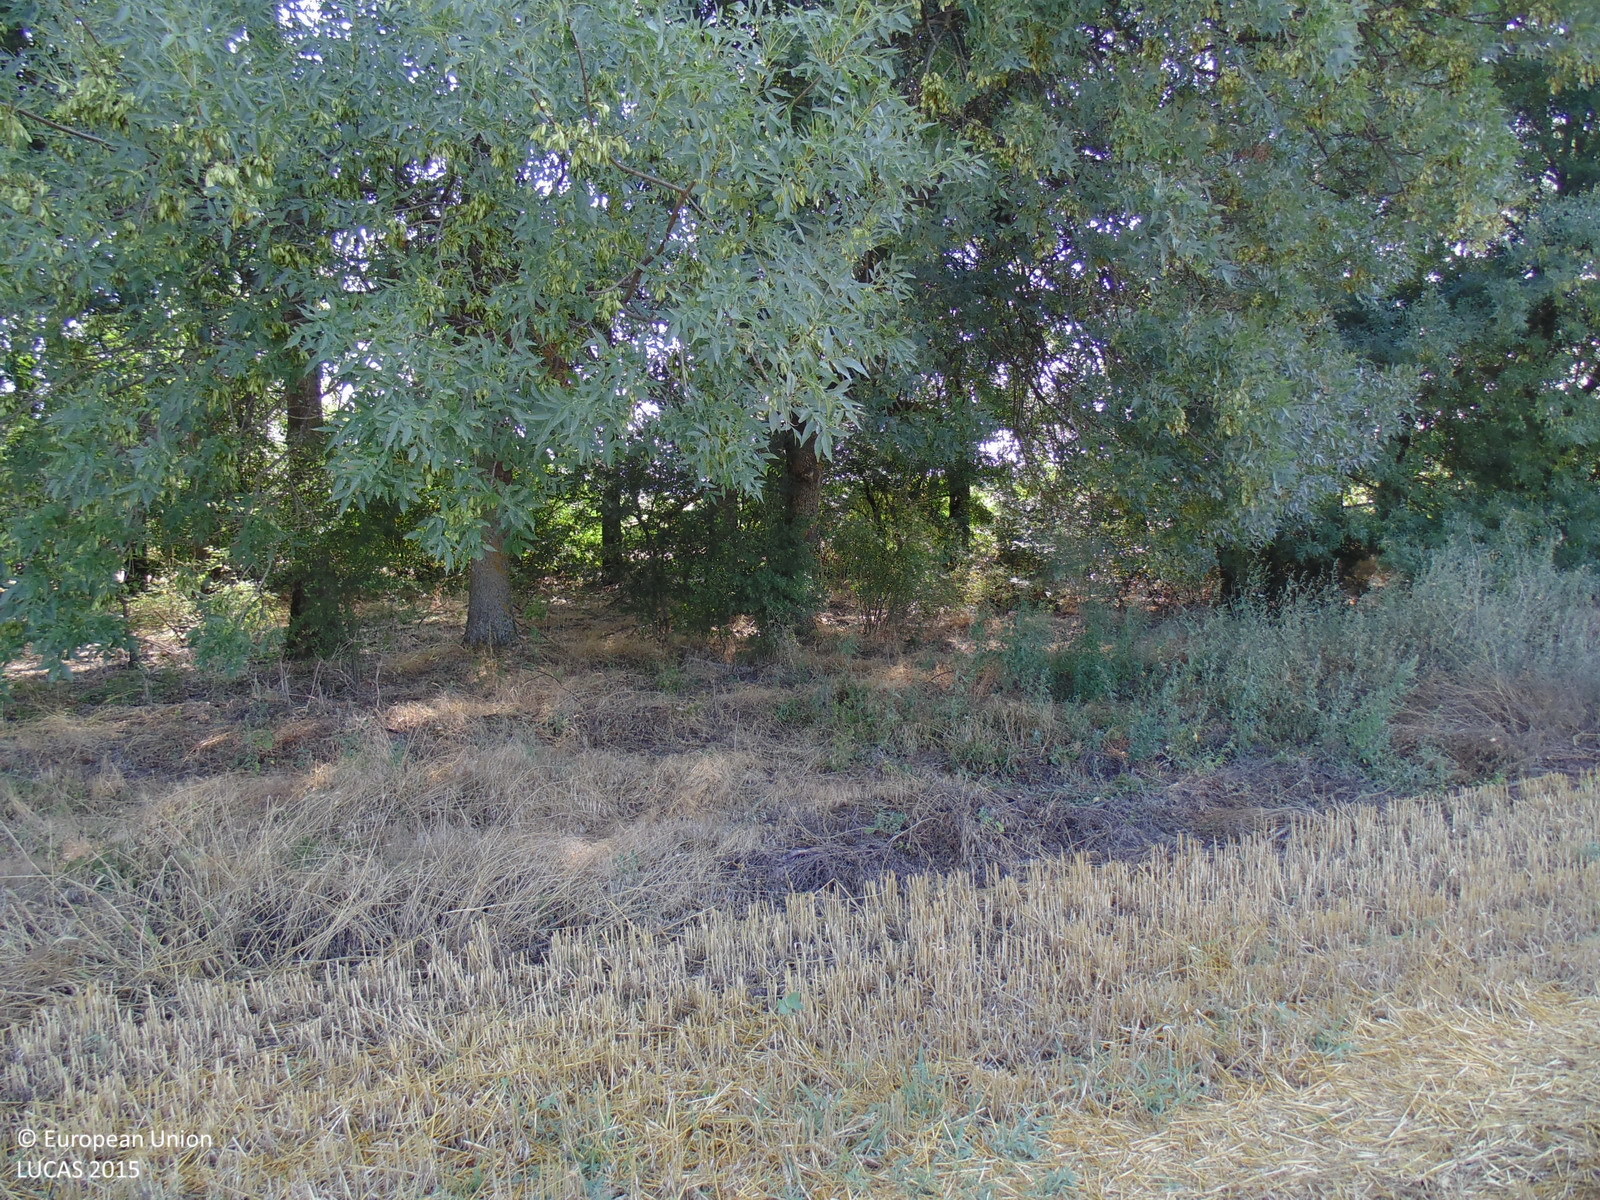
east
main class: Cropland
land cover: Common wheat
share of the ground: 50 - 75 %
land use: Agriculture (excluding fallow land and kitchen gardens)
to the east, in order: Common wheat; Grass margins; Broadleaved woodland; Grass margins; Tracks; Grass margins; Rape and turnip rape
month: August
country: BG
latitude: 43.6701
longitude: 28.0713
